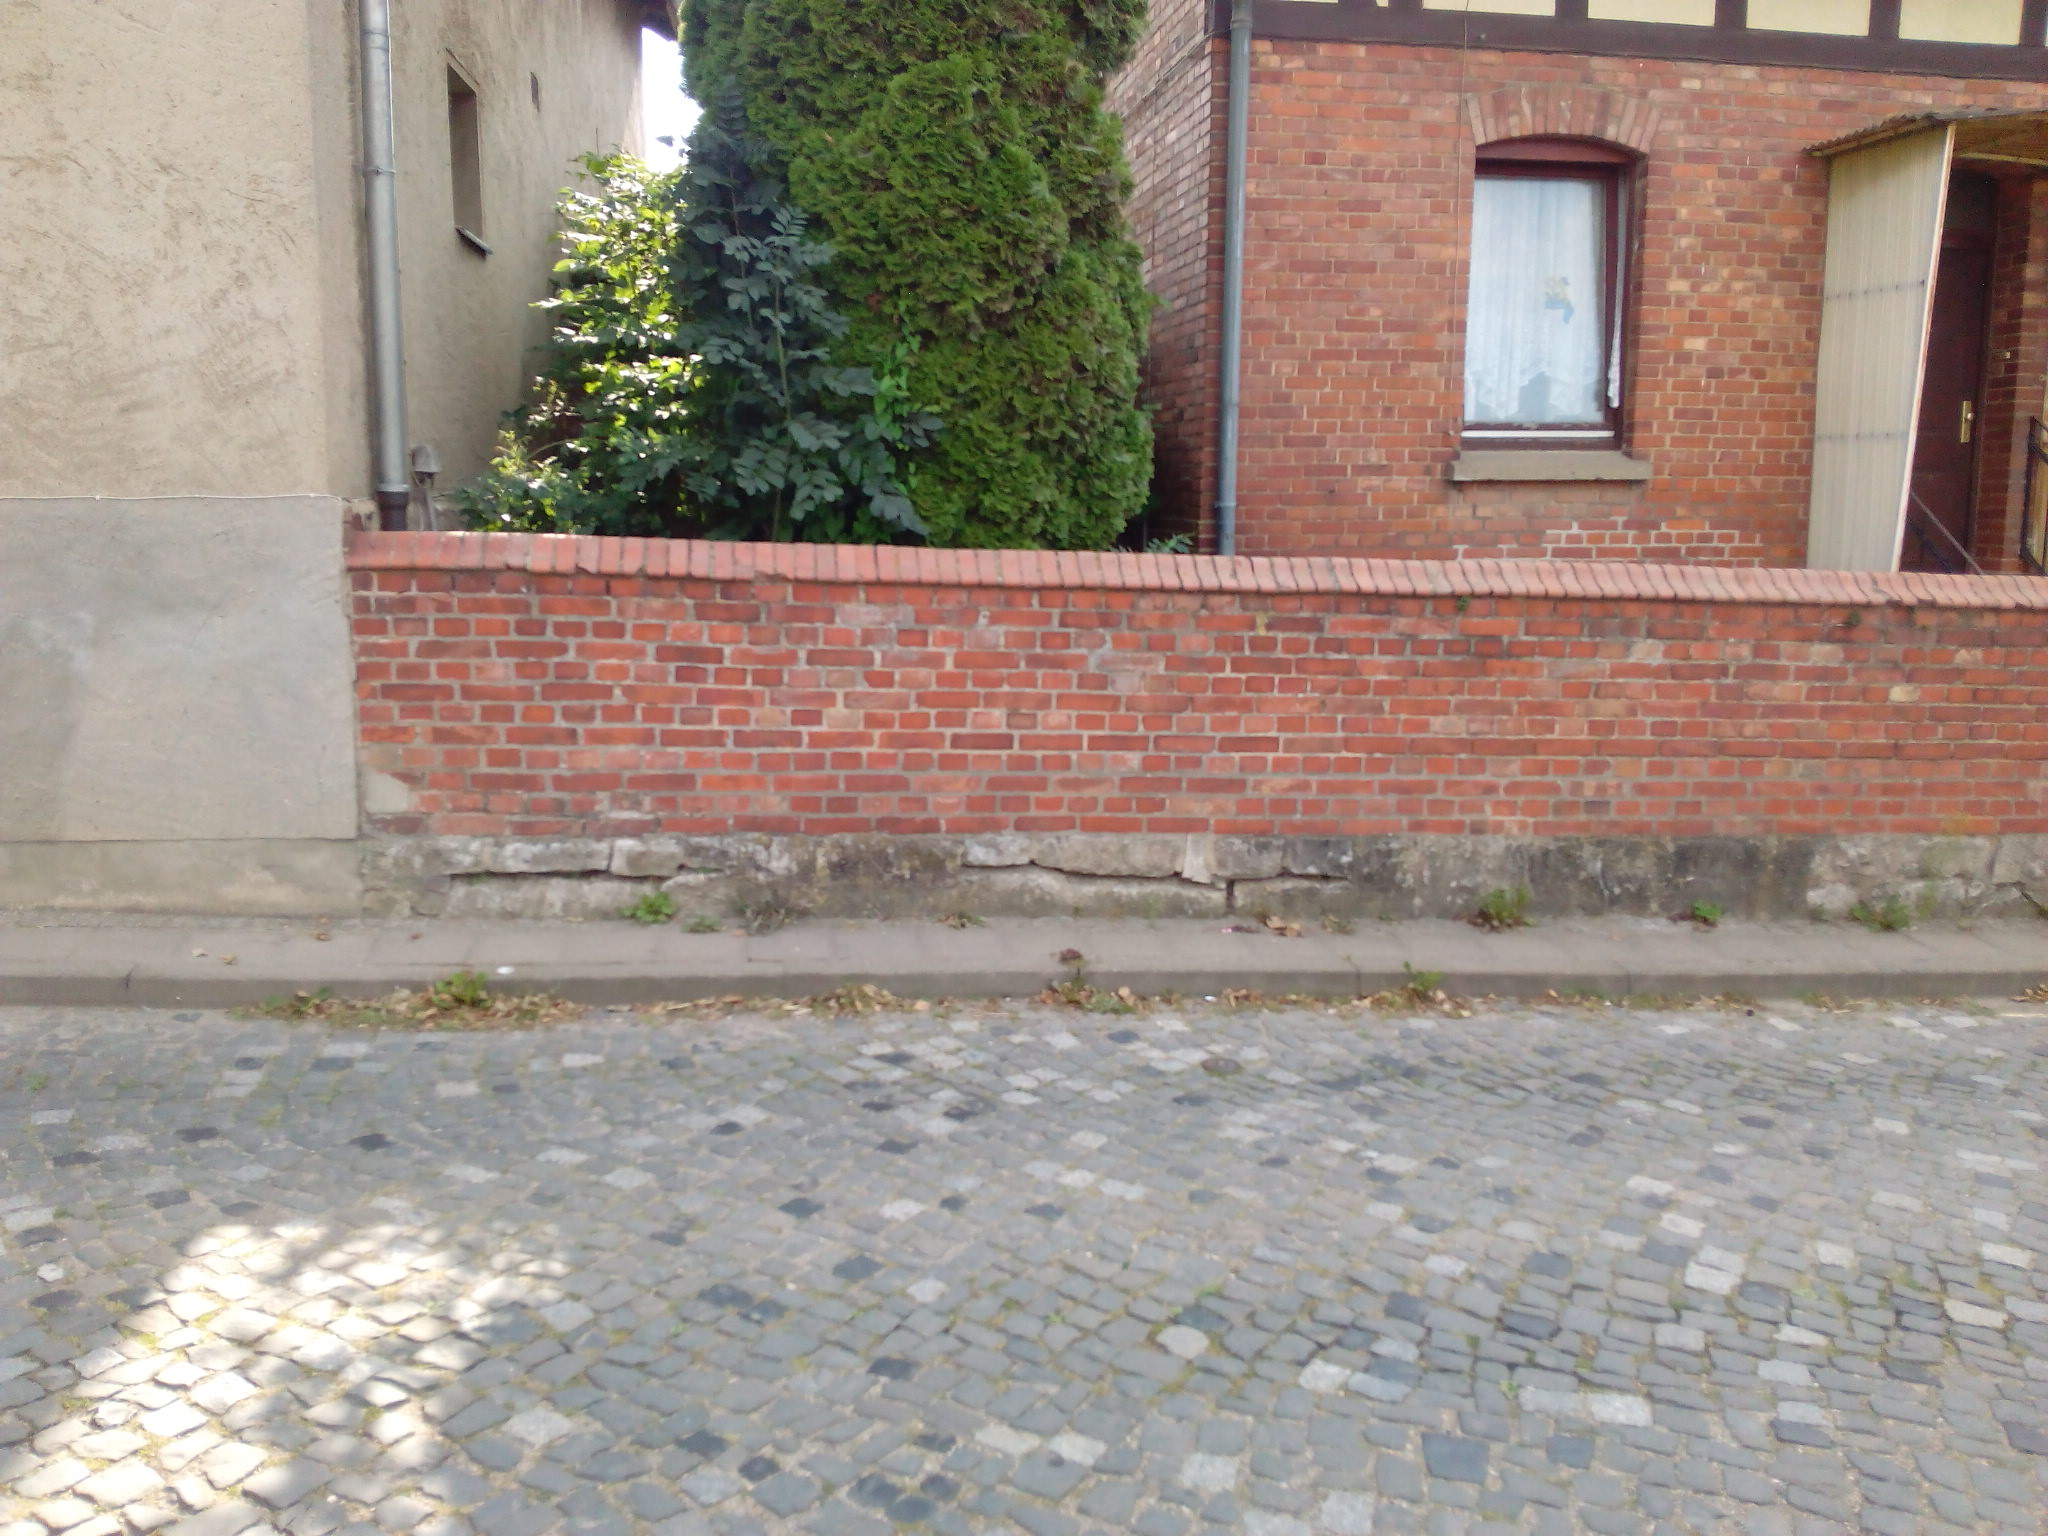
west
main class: Grassland
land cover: Grassland with sparse tree/shrub cover
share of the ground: > 75 %
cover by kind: herbaceous plants 95 %, broadleaved forest trees 5 %
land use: Agriculture (excluding fallow land and kitchen gardens)
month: August
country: DE
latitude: 52.1977
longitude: 9.8976
